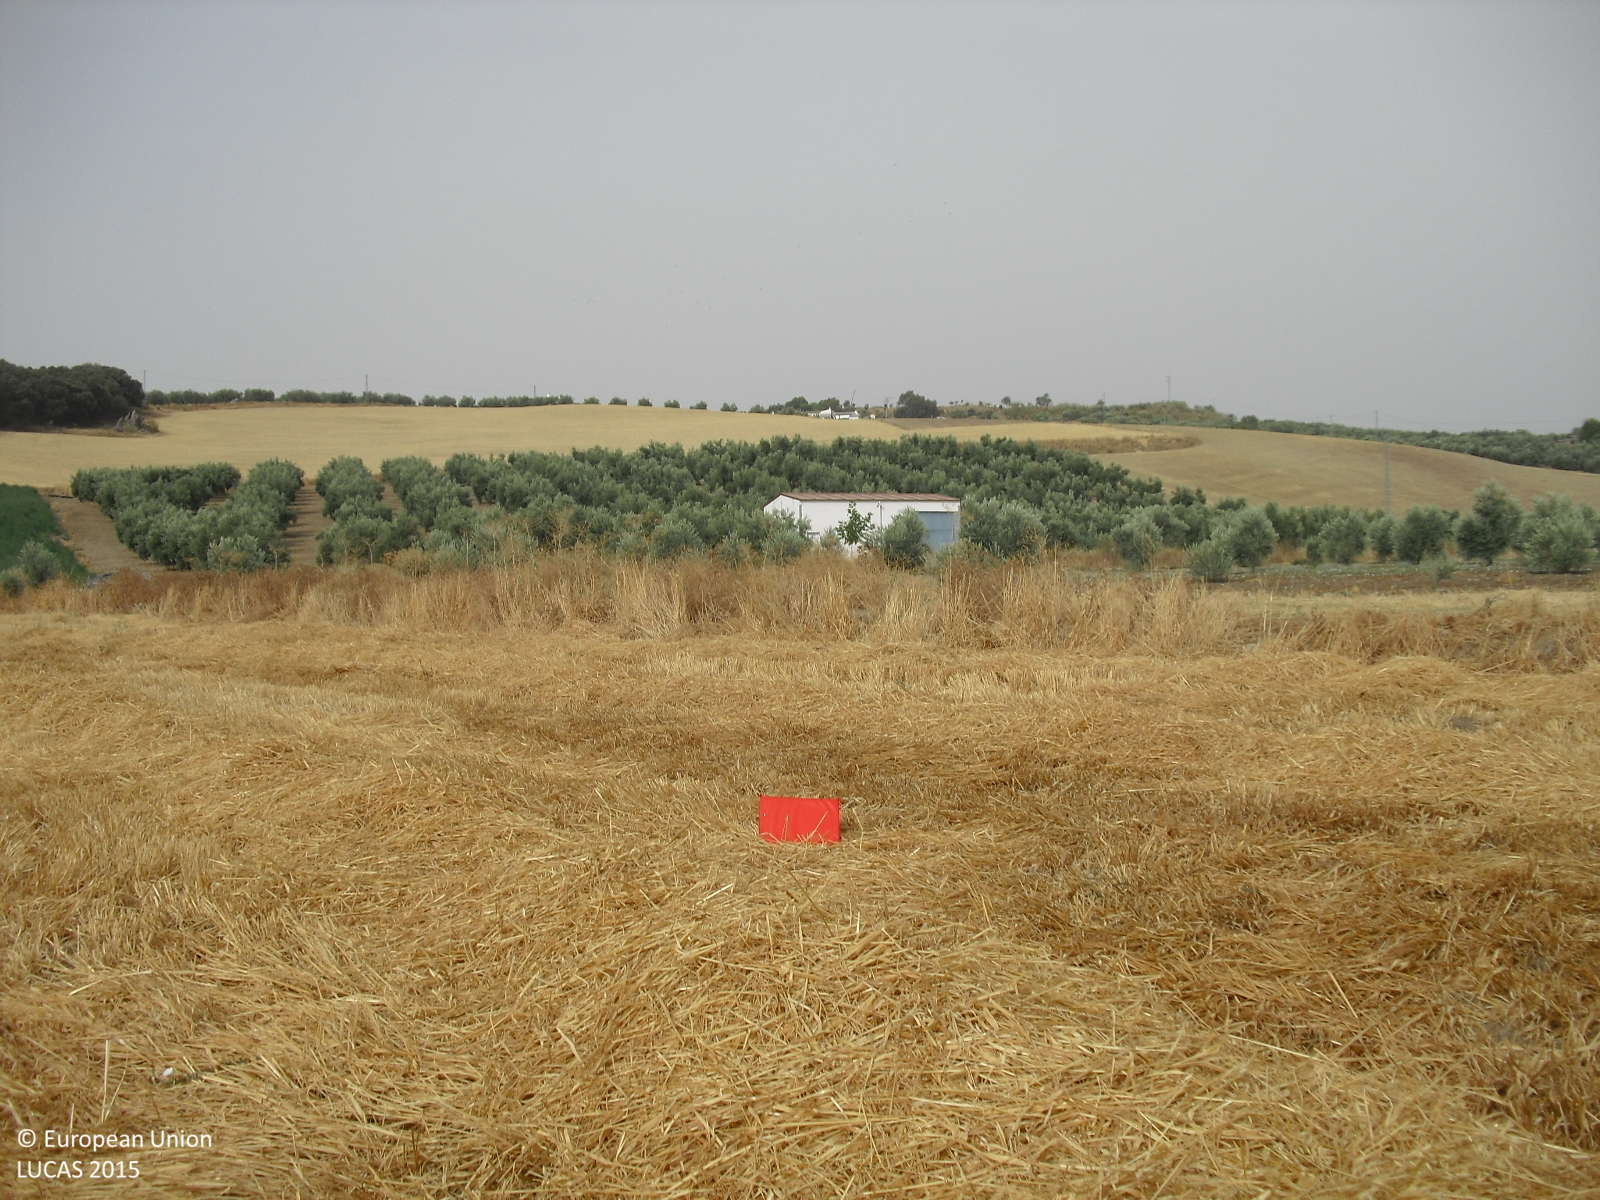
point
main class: Cropland
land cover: Oats
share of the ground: < 10 %
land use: Agriculture (excluding fallow land and kitchen gardens)
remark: Harvested field
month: August
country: ES
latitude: 37.2184
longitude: -4.1384
